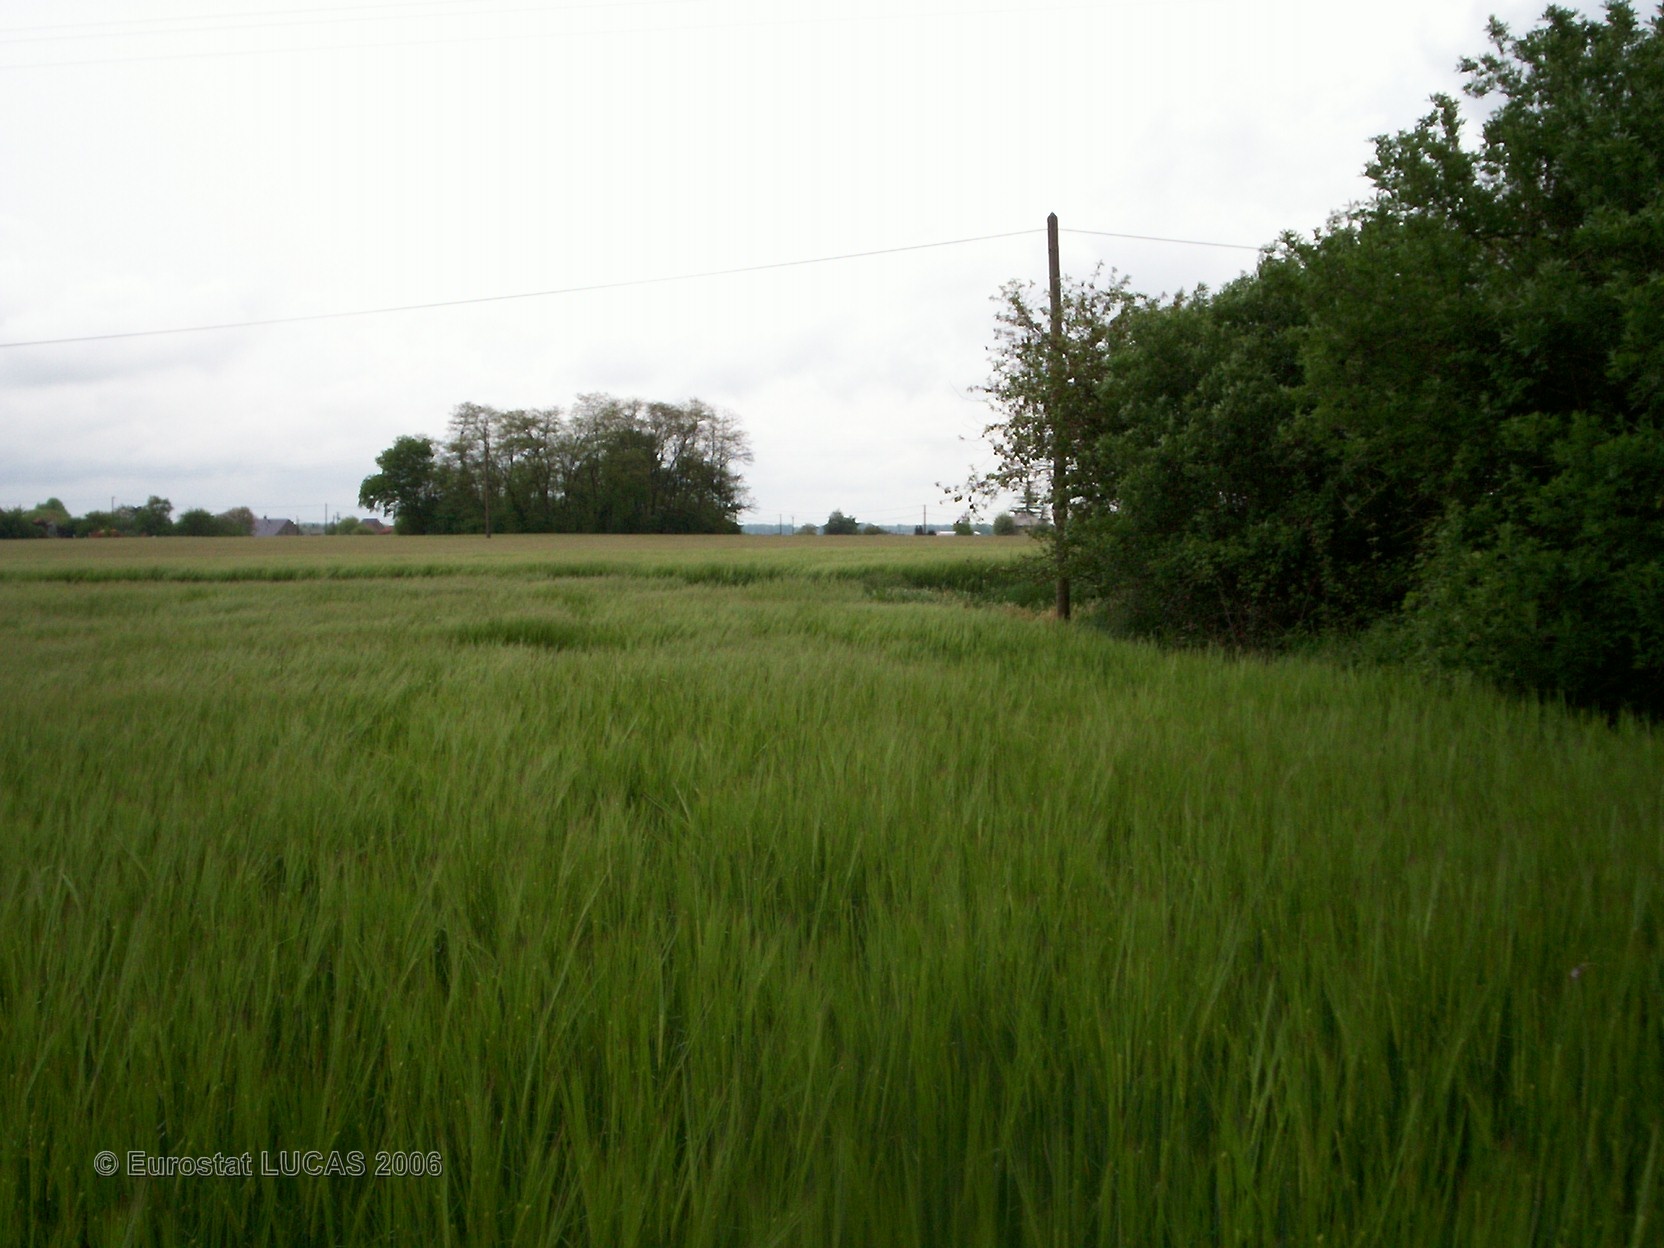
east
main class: Cropland
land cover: Barley
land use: Agriculture (excluding fallow land and kitchen gardens)
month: May
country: FR
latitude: 47.9982
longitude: 2.9566
